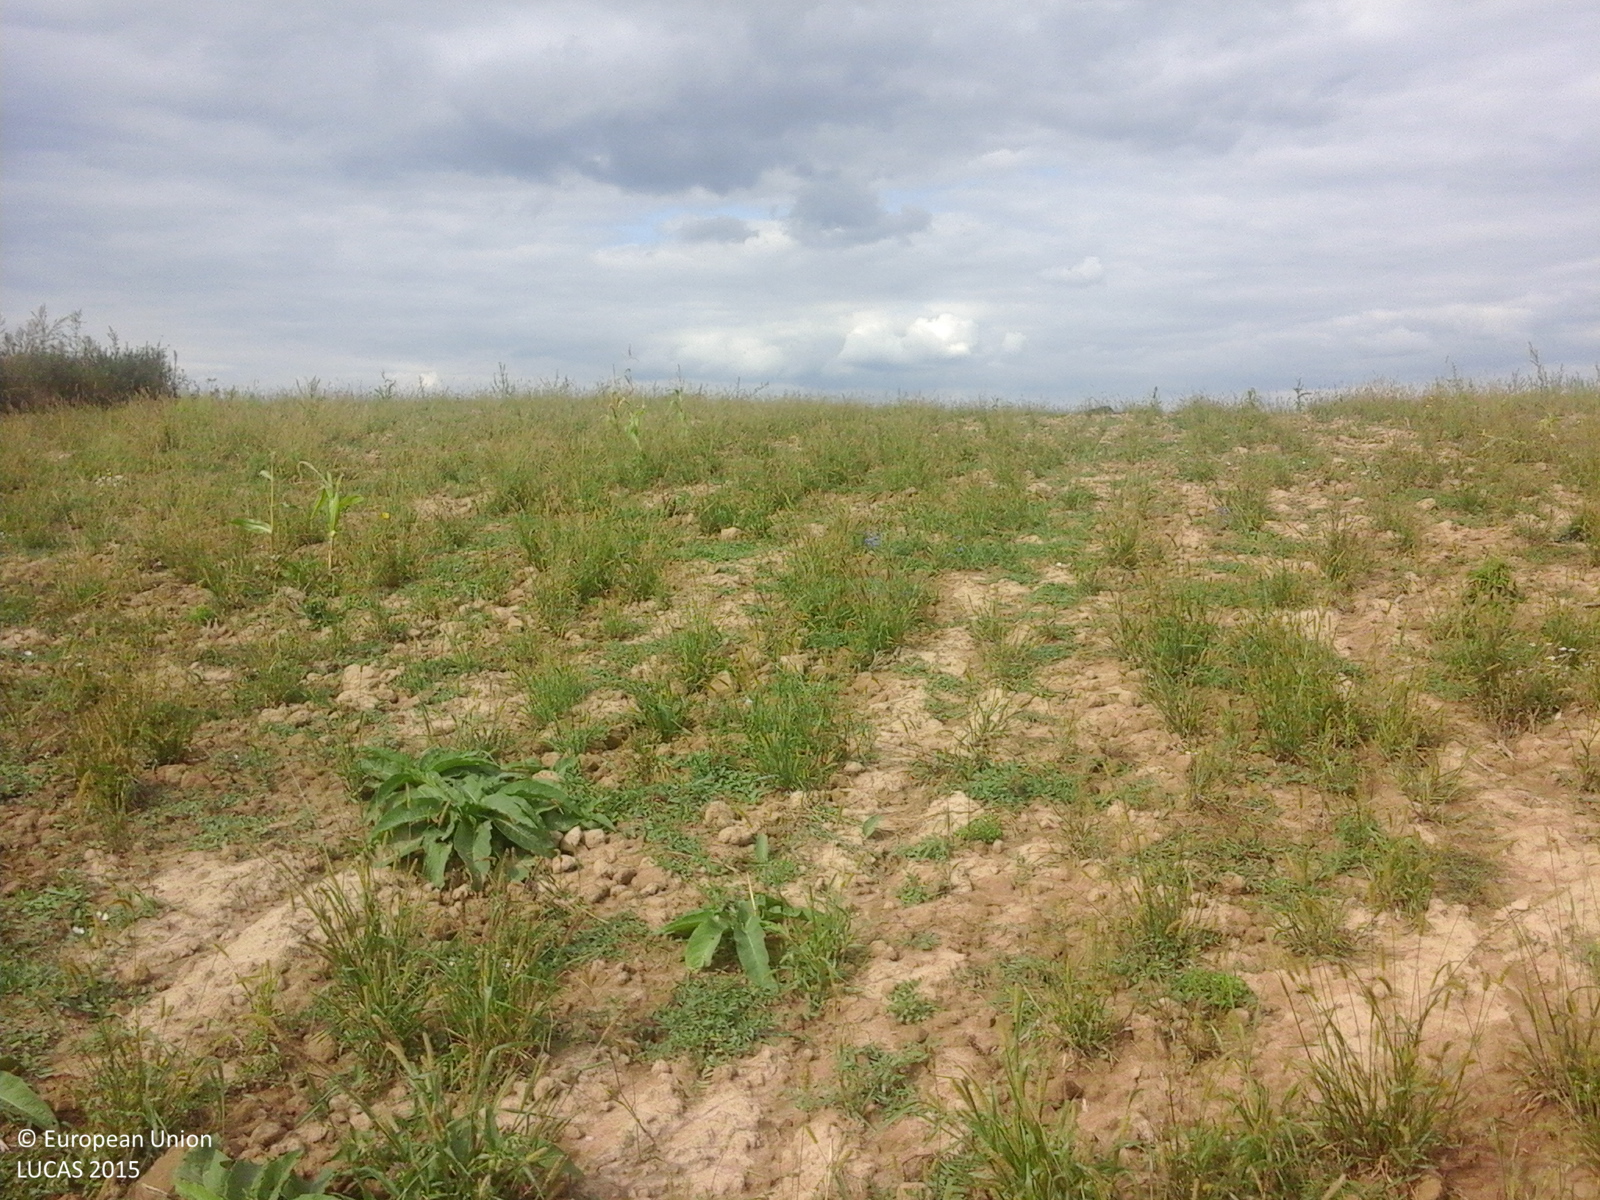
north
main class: Grassland
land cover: Spontaneously vegetated surfaces
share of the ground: > 75 %
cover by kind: herbaceous plants 100 %
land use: Fallow land
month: September
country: RO
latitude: 47.4522
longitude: 23.1313
